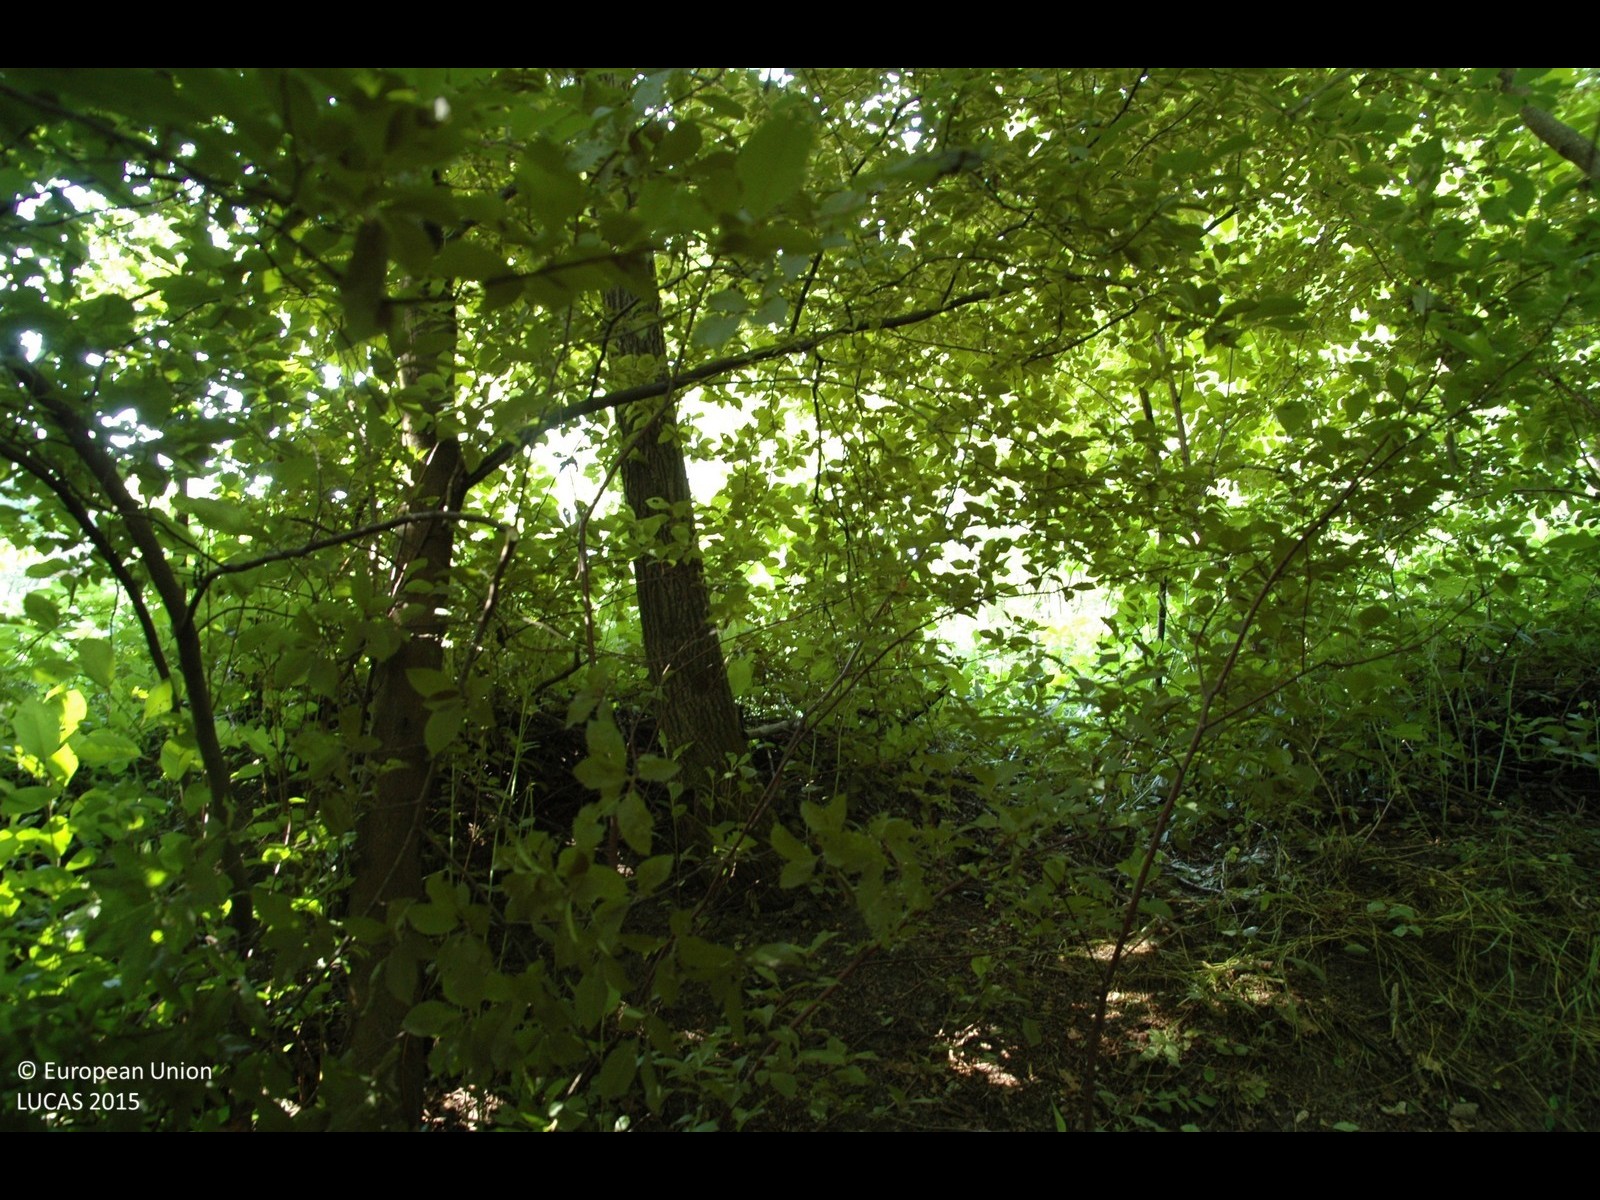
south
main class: Woodland
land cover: Broadleaved woodland
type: mesophytic deciduous forest
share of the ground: > 75 %
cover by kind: broadleaved forest trees 90 %, shrubs 5 %, herbaceous plants 5 %
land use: Forestry
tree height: > 5 m
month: May
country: HR
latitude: 46.4997
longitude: 16.4509
